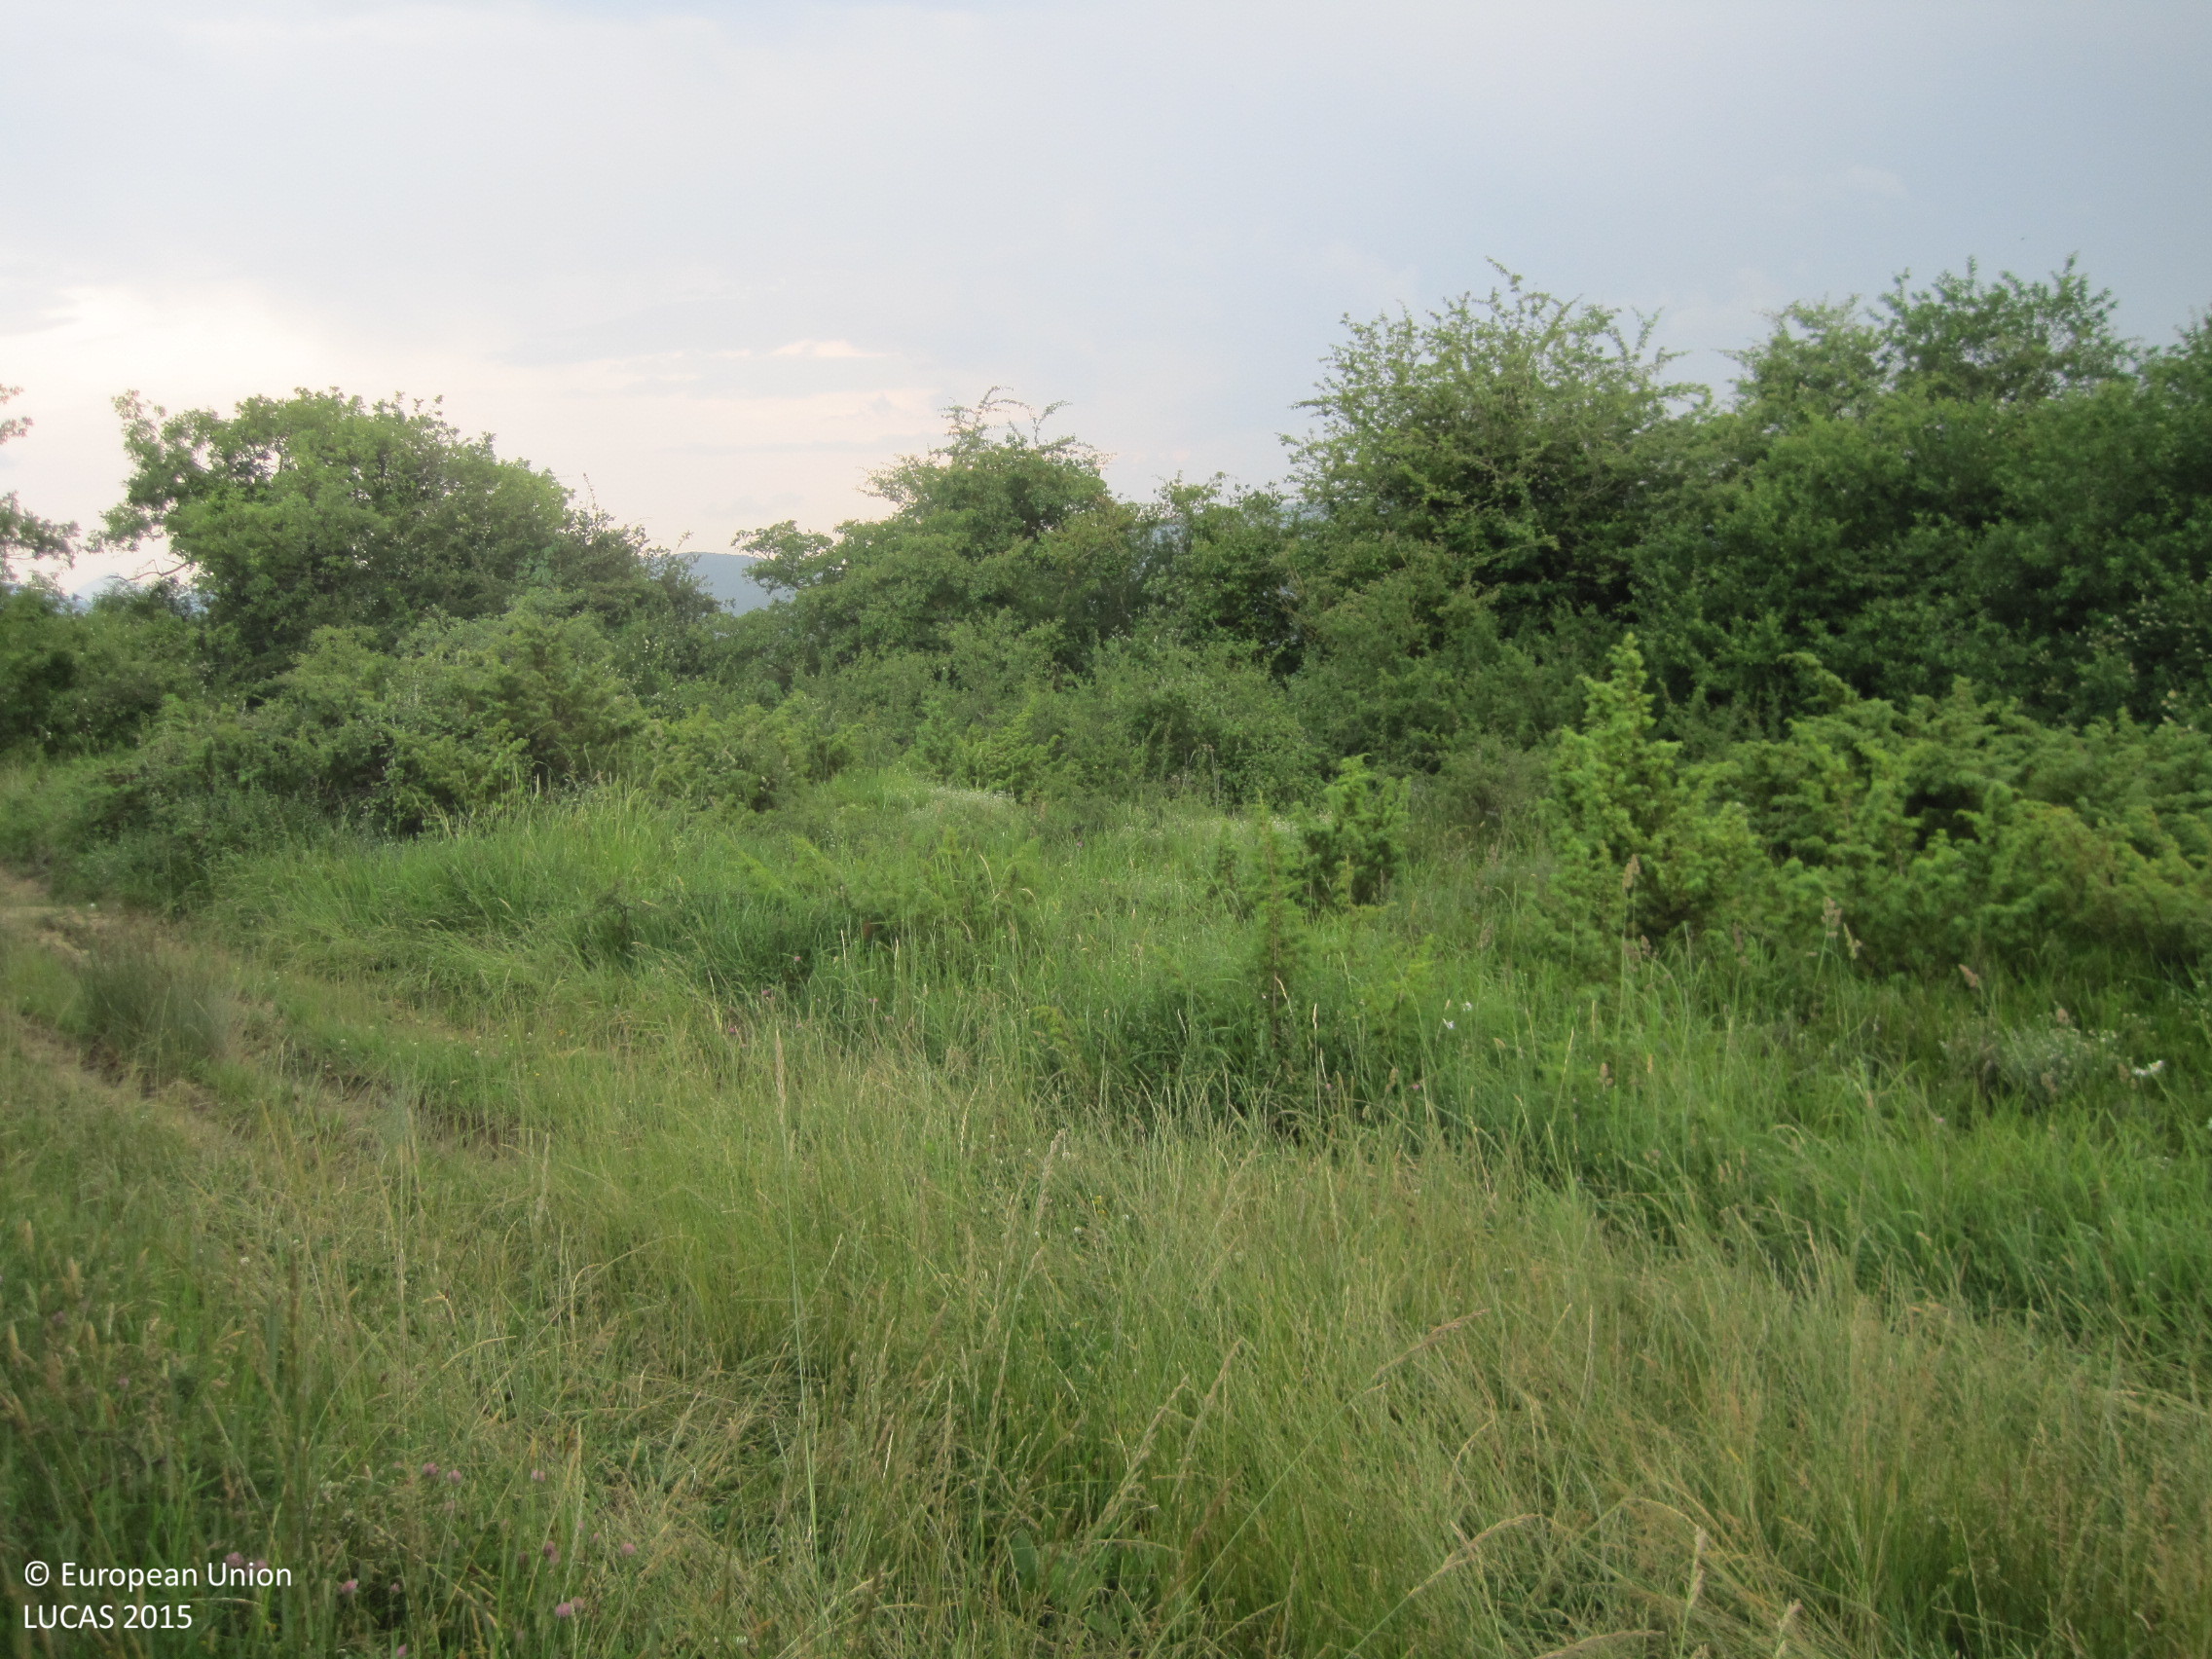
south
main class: Shrubland
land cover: Shrubland without tree cover
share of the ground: 10 - 25 %
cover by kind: herbaceous plants 80 %, shrubs 20 %
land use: Semi-natural and natural areas not in use
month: June
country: ES
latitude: 42.9728
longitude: -1.7264
